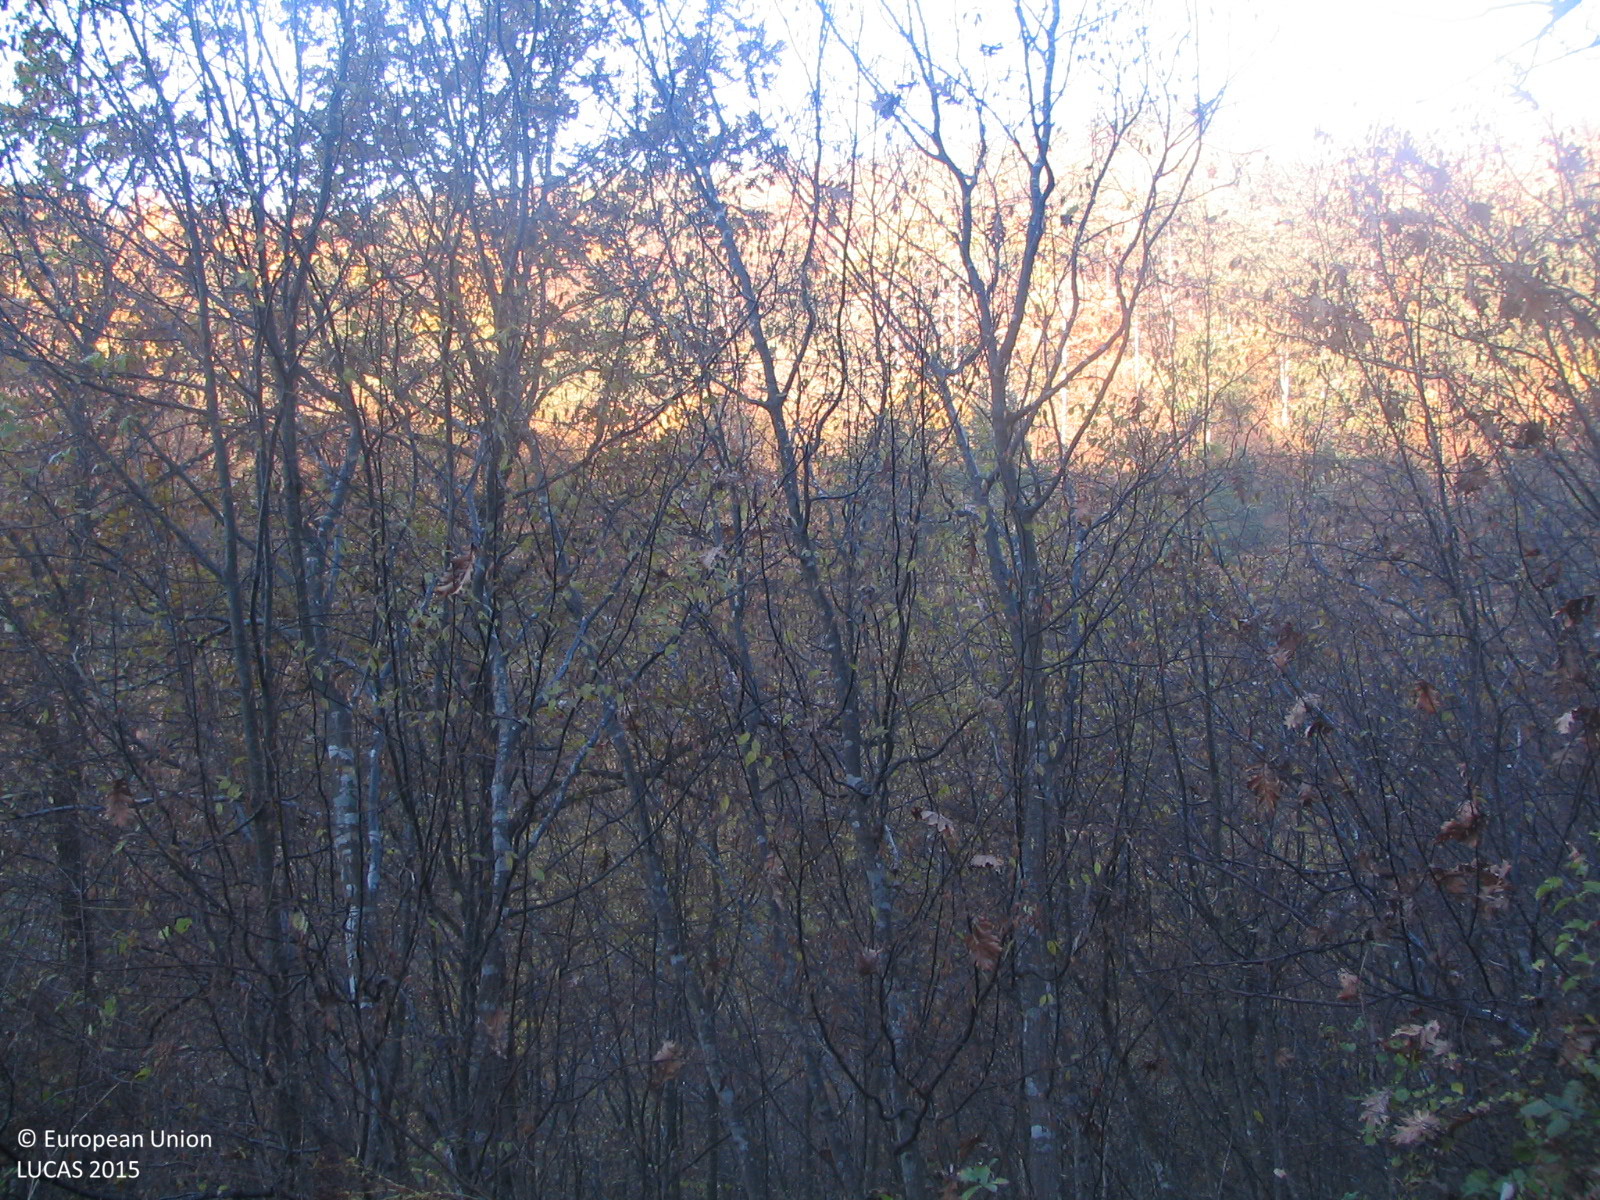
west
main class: Woodland
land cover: Broadleaved woodland
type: acidophilous oak and oak-birch forest
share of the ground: > 75 %
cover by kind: broadleaved forest trees 90 %, shrubs 5 %, herbaceous plants 5 %
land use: Forestry
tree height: > 5 m
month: November
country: BG
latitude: 42.9923
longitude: 23.7438
